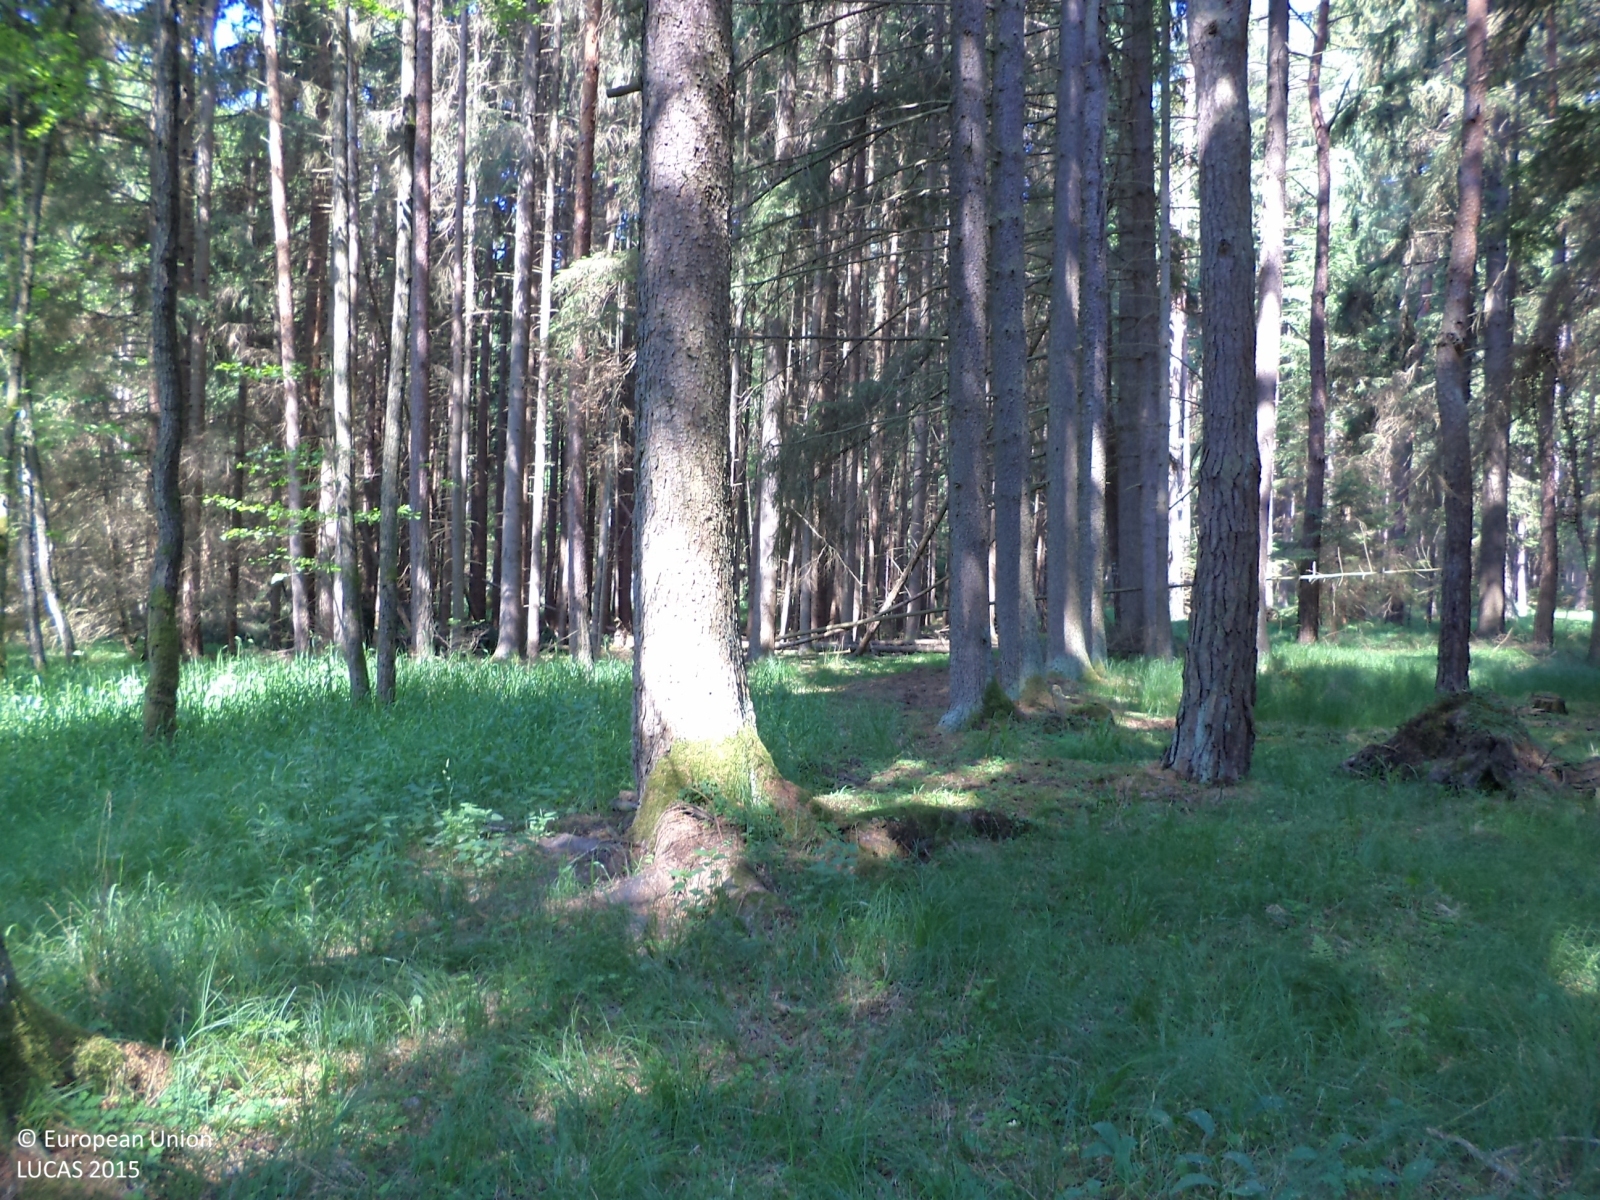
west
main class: Woodland
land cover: Spruce dominated coniferous woodland
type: hemiboreal forest and nemoral coniferous forest and mixed broadleaved-coniferous forest
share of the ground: > 75 %
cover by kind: coniferous forest trees 80 %, herbaceous plants 20 %
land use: Forestry
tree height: > 5 m
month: June
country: CZ
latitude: 49.3421
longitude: 14.4194
